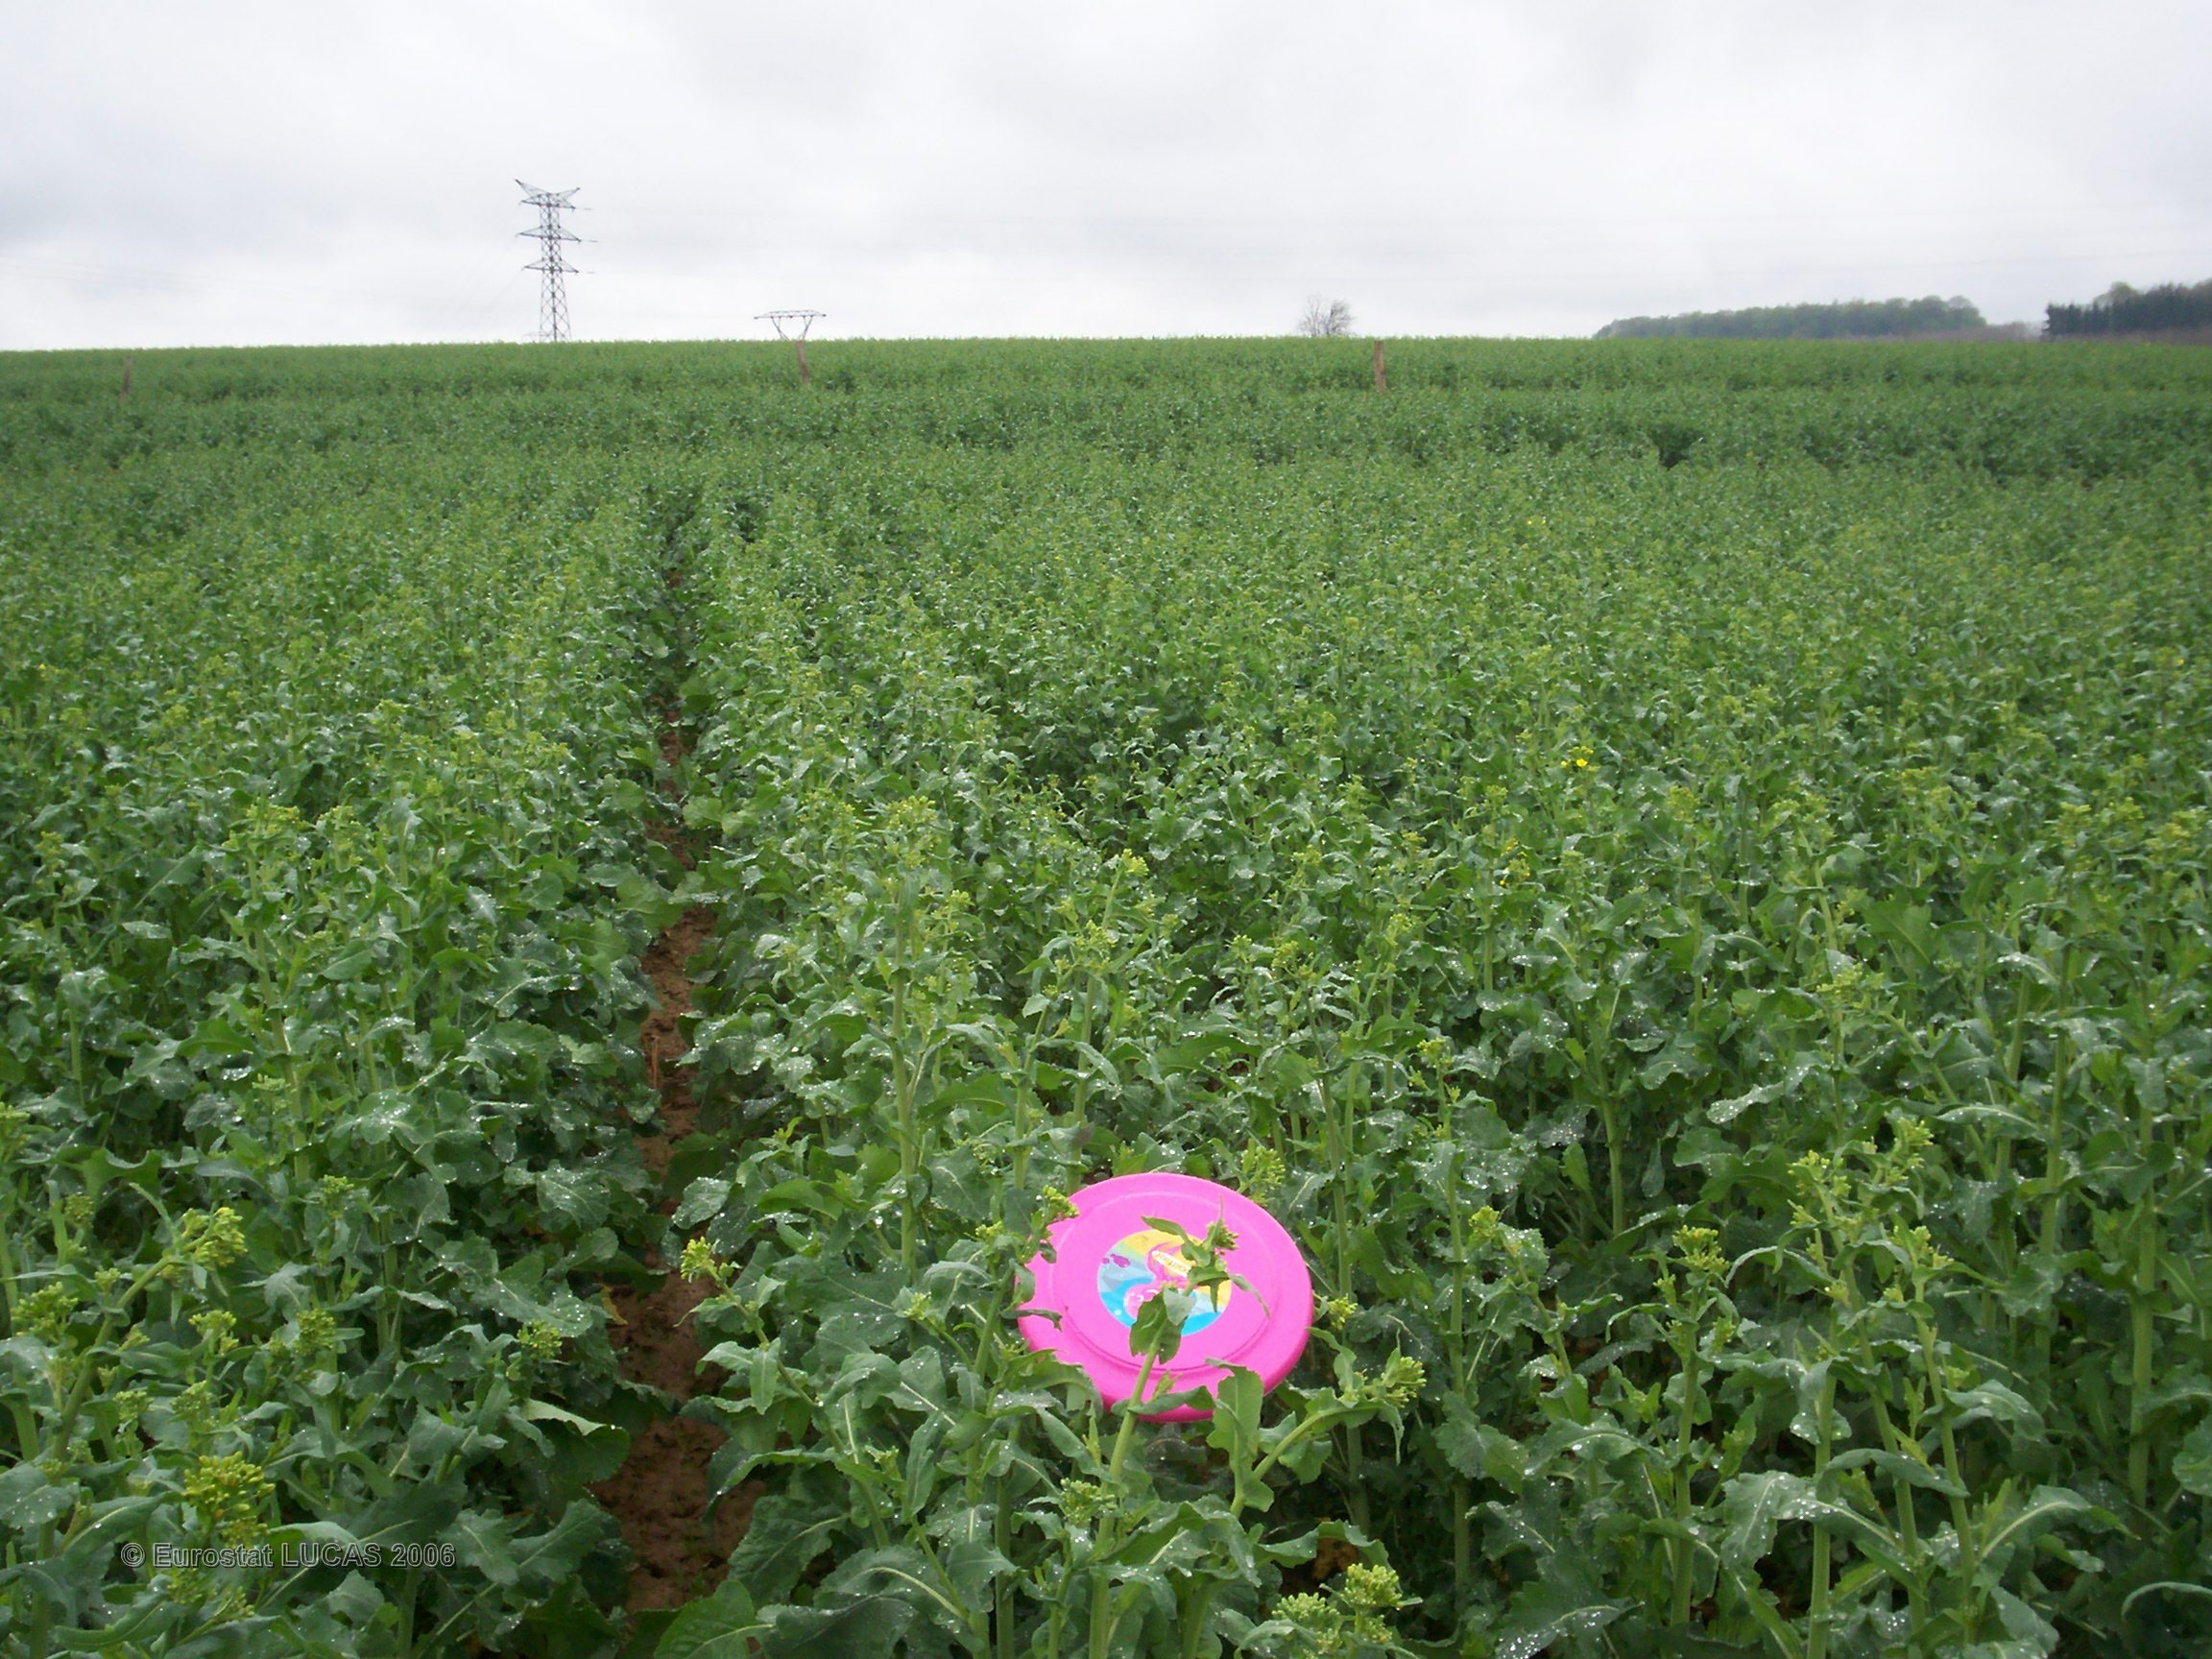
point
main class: Cropland
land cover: Rape and turnip rape
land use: Agriculture (excluding fallow land and kitchen gardens)
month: April
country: FR
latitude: 47.7031
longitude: 6.0697
